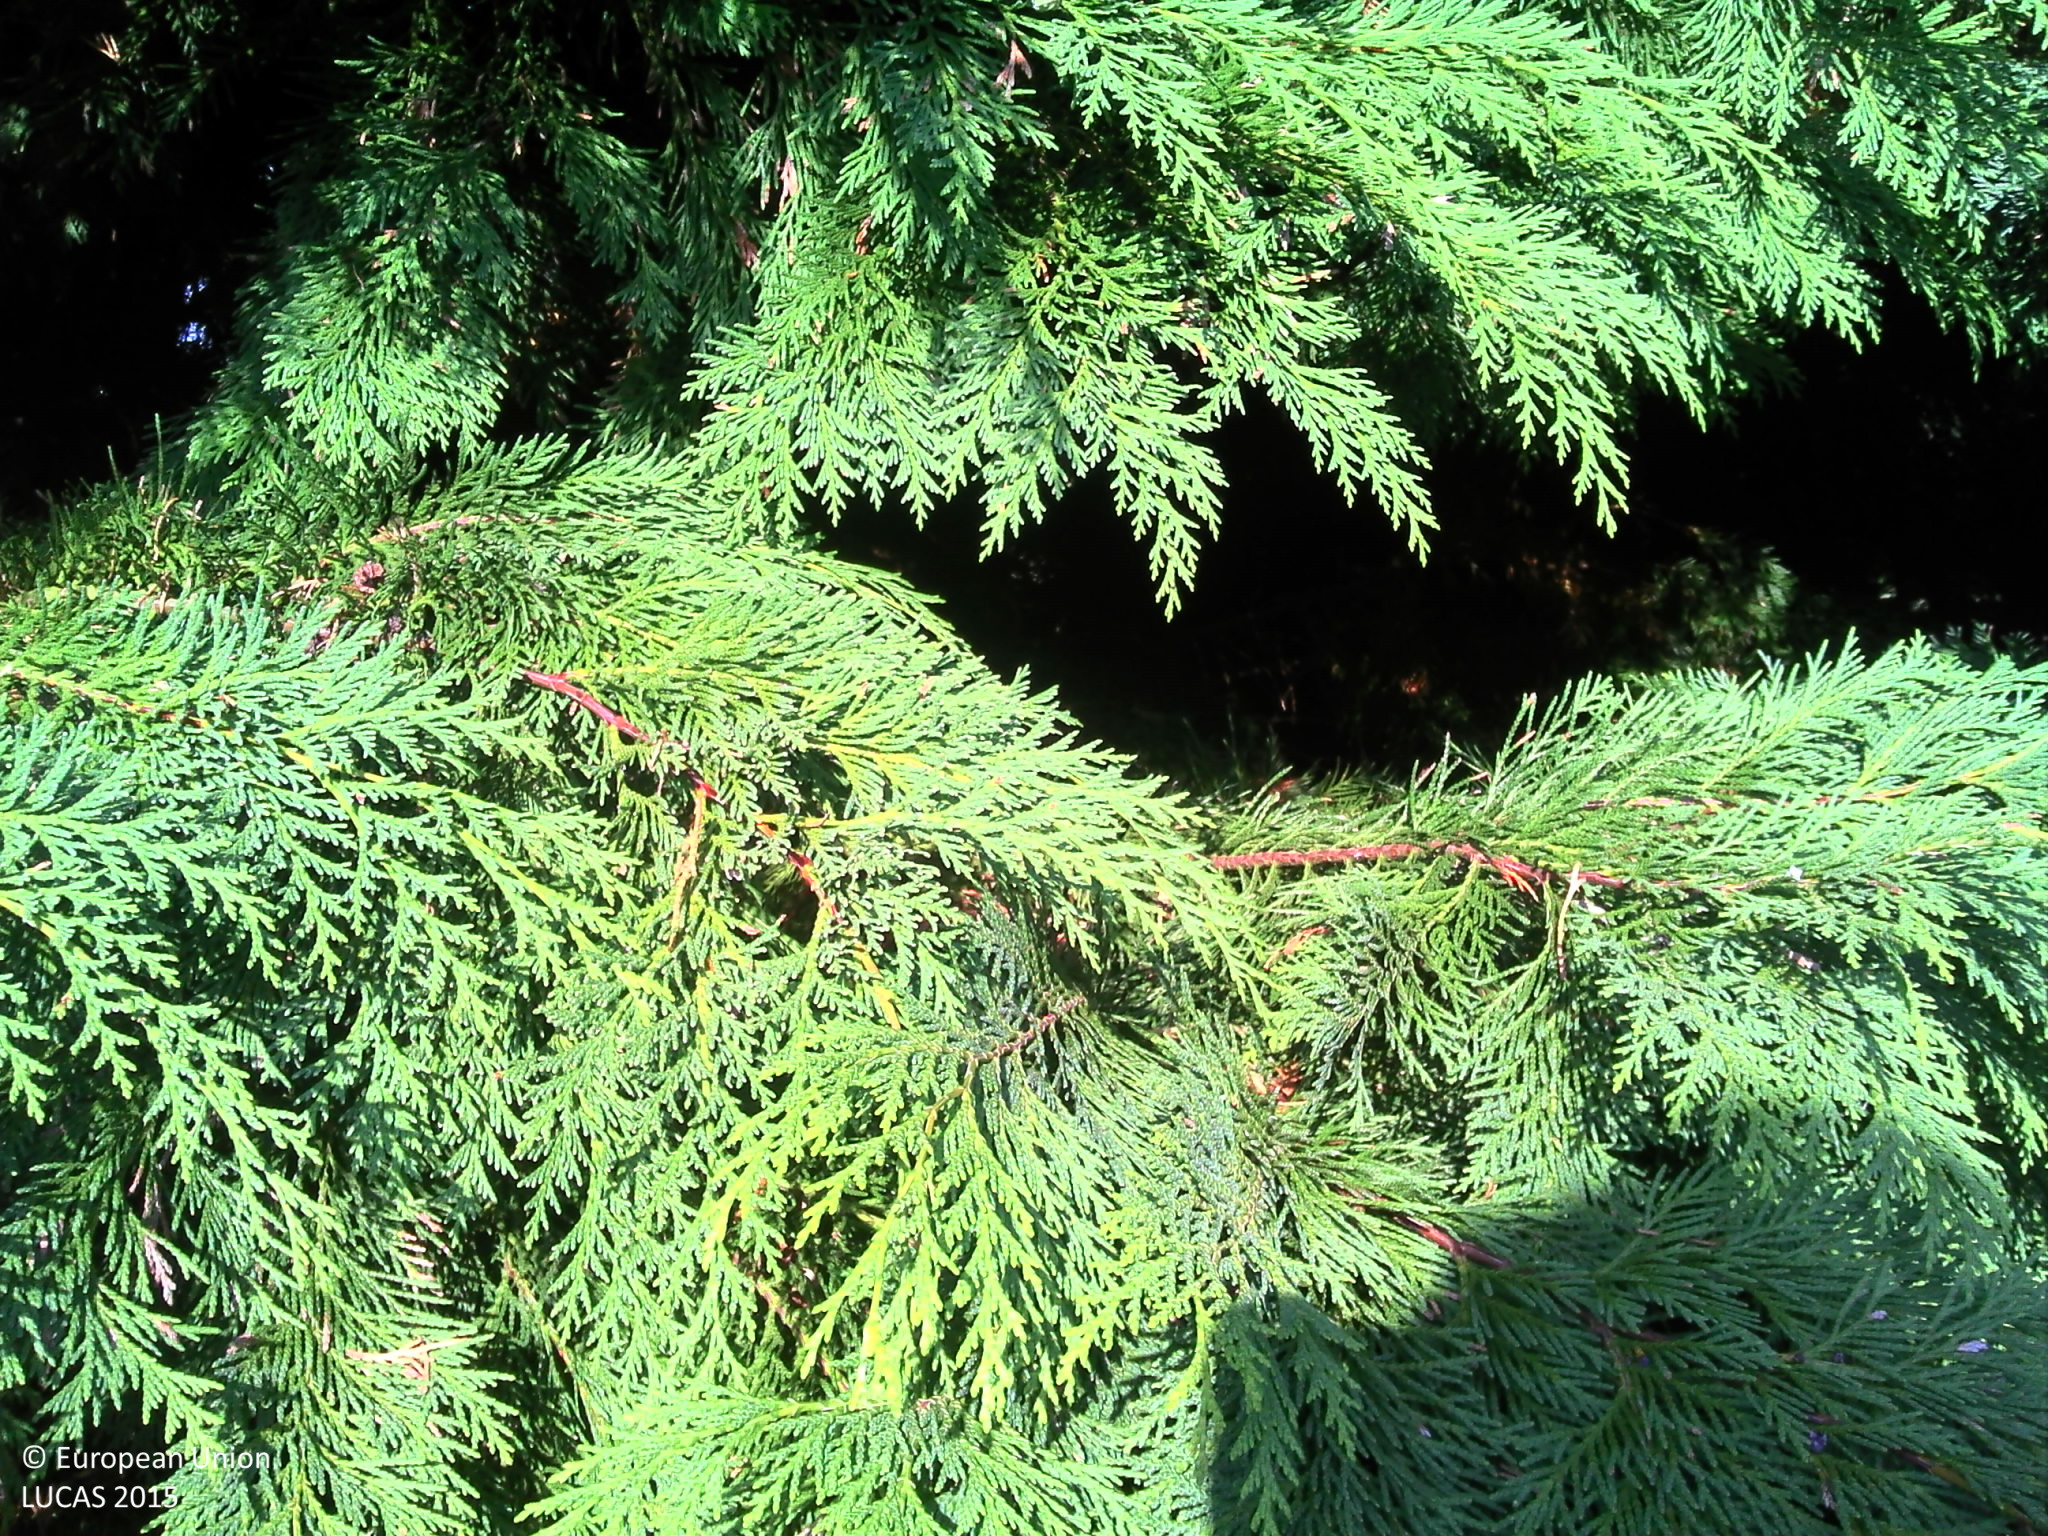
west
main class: Grassland
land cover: Spontaneously vegetated surfaces
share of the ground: > 75 %
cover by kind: herbaceous plants 100 %
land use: Residential
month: August
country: BE
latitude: 51.1810
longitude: 5.1765
